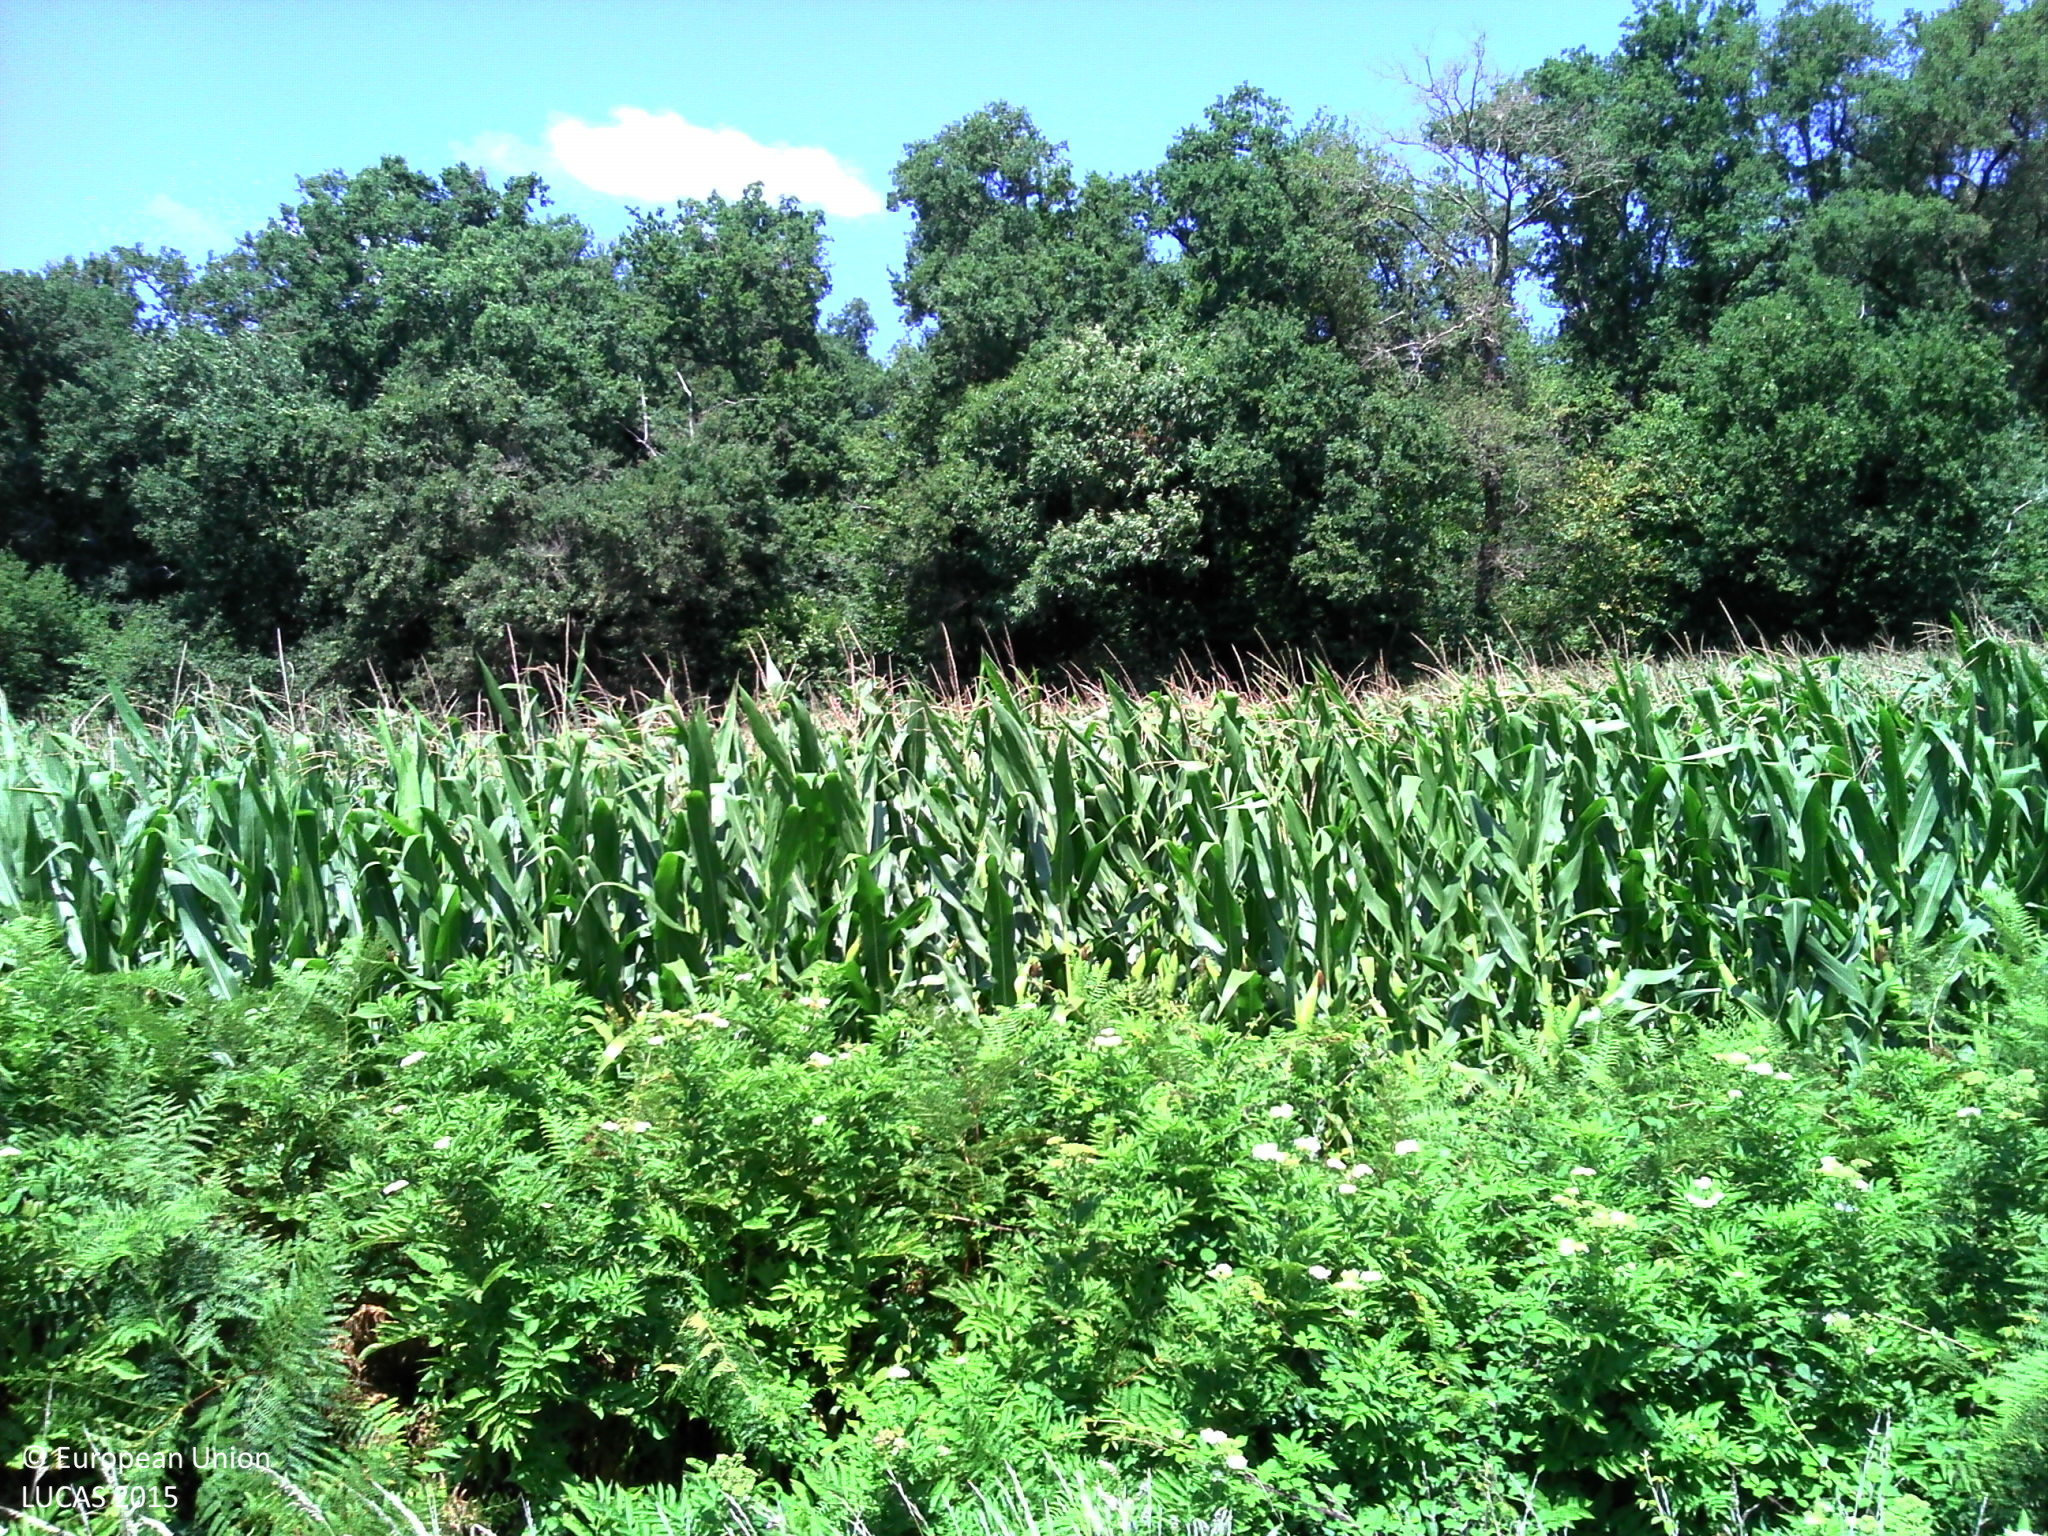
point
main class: Cropland
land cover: Maize
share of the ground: > 75 %
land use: Agriculture (excluding fallow land and kitchen gardens)
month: August
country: FR
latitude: 43.7076
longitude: -0.4972
